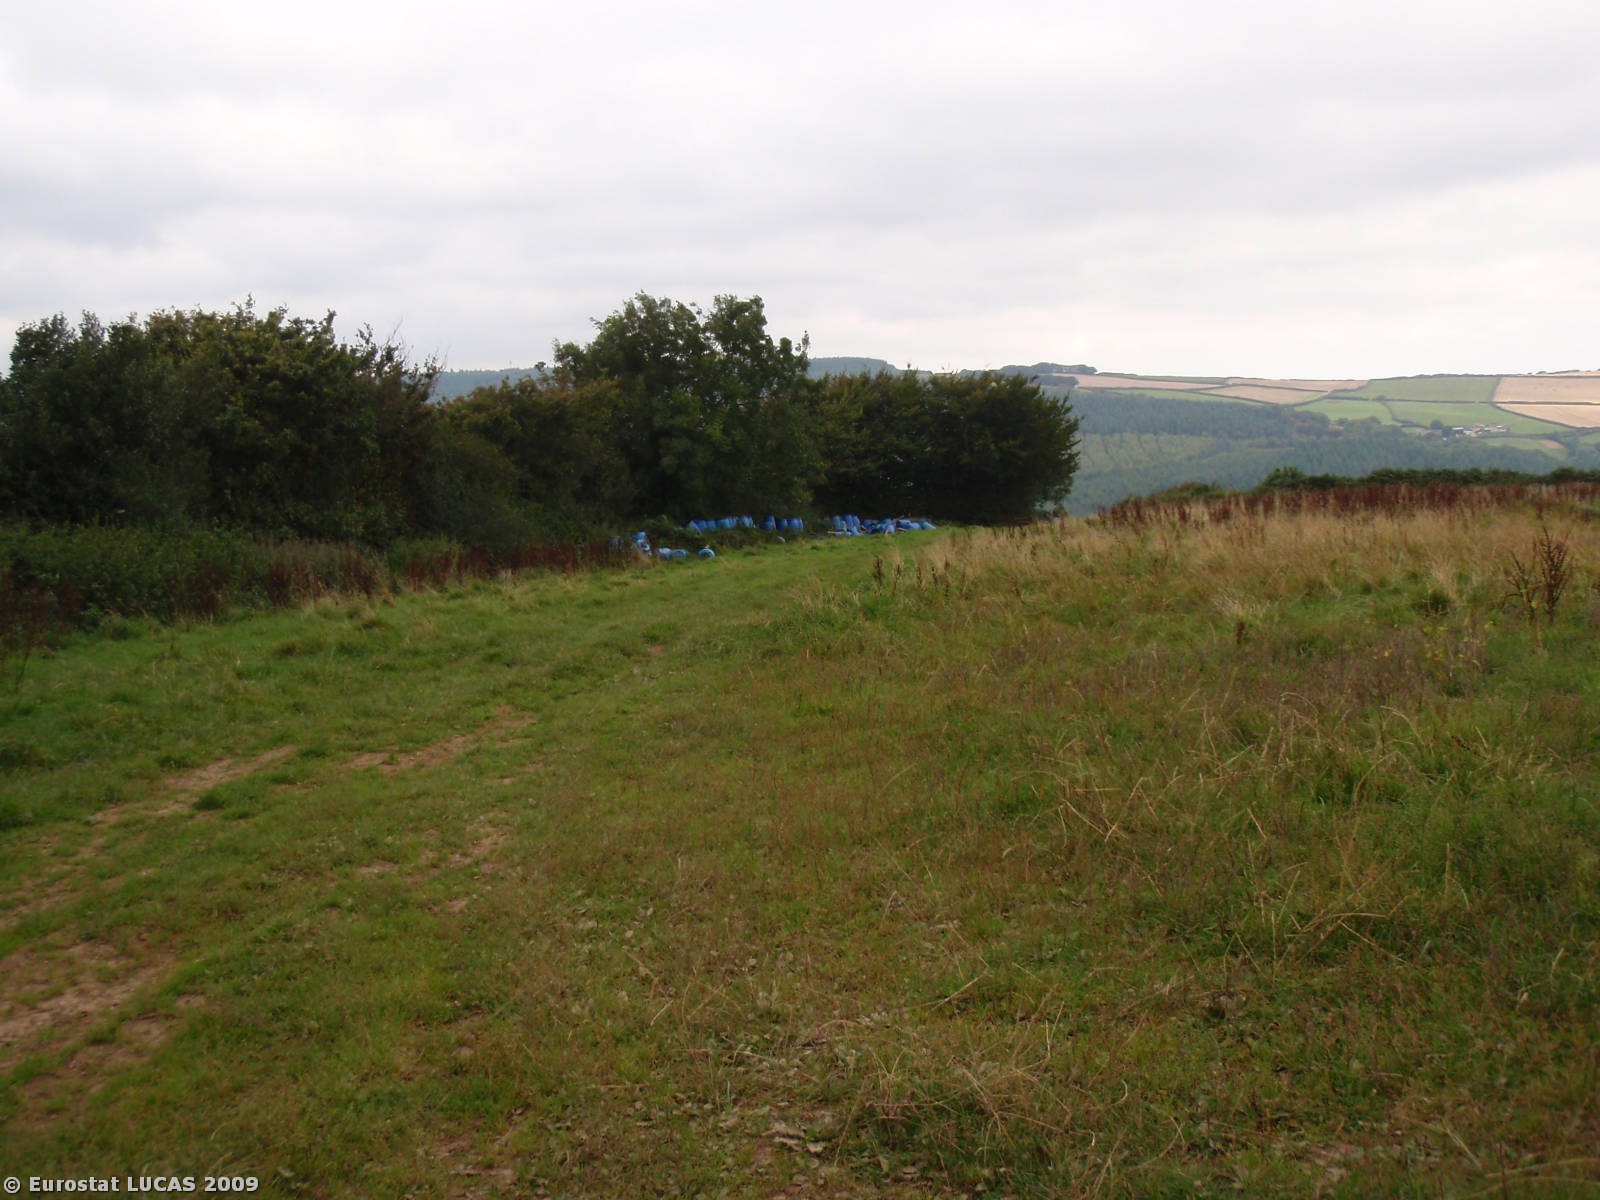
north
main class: Grassland
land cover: Grassland without tree/shrub cover
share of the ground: 50 - 75 %
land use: Agriculture (excluding fallow land and kitchen gardens)
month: September
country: GB
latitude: 51.1162
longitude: -3.4401
